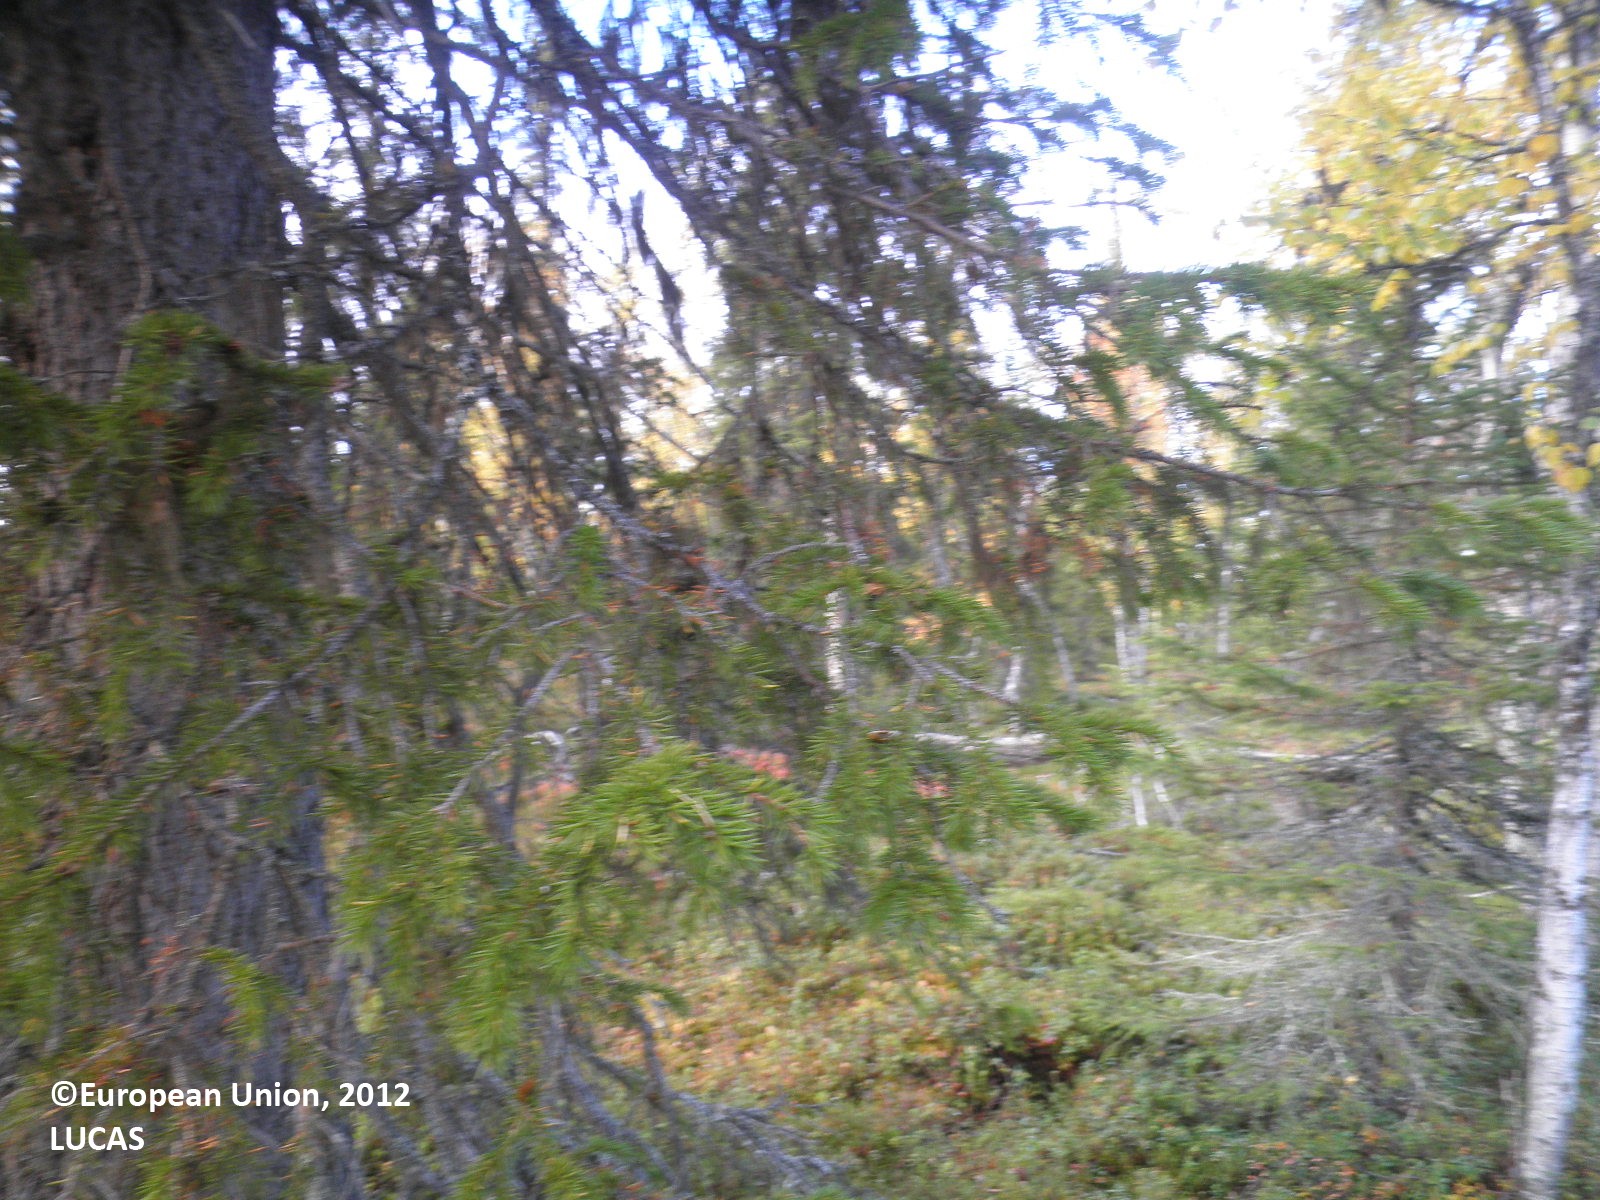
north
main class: Woodland
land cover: Spruce dominated mixed woodland
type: boreal forest
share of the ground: 25 - 50 %
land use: Forestry
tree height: > 5 m
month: September
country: FI
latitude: 67.7646
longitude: 28.7202
